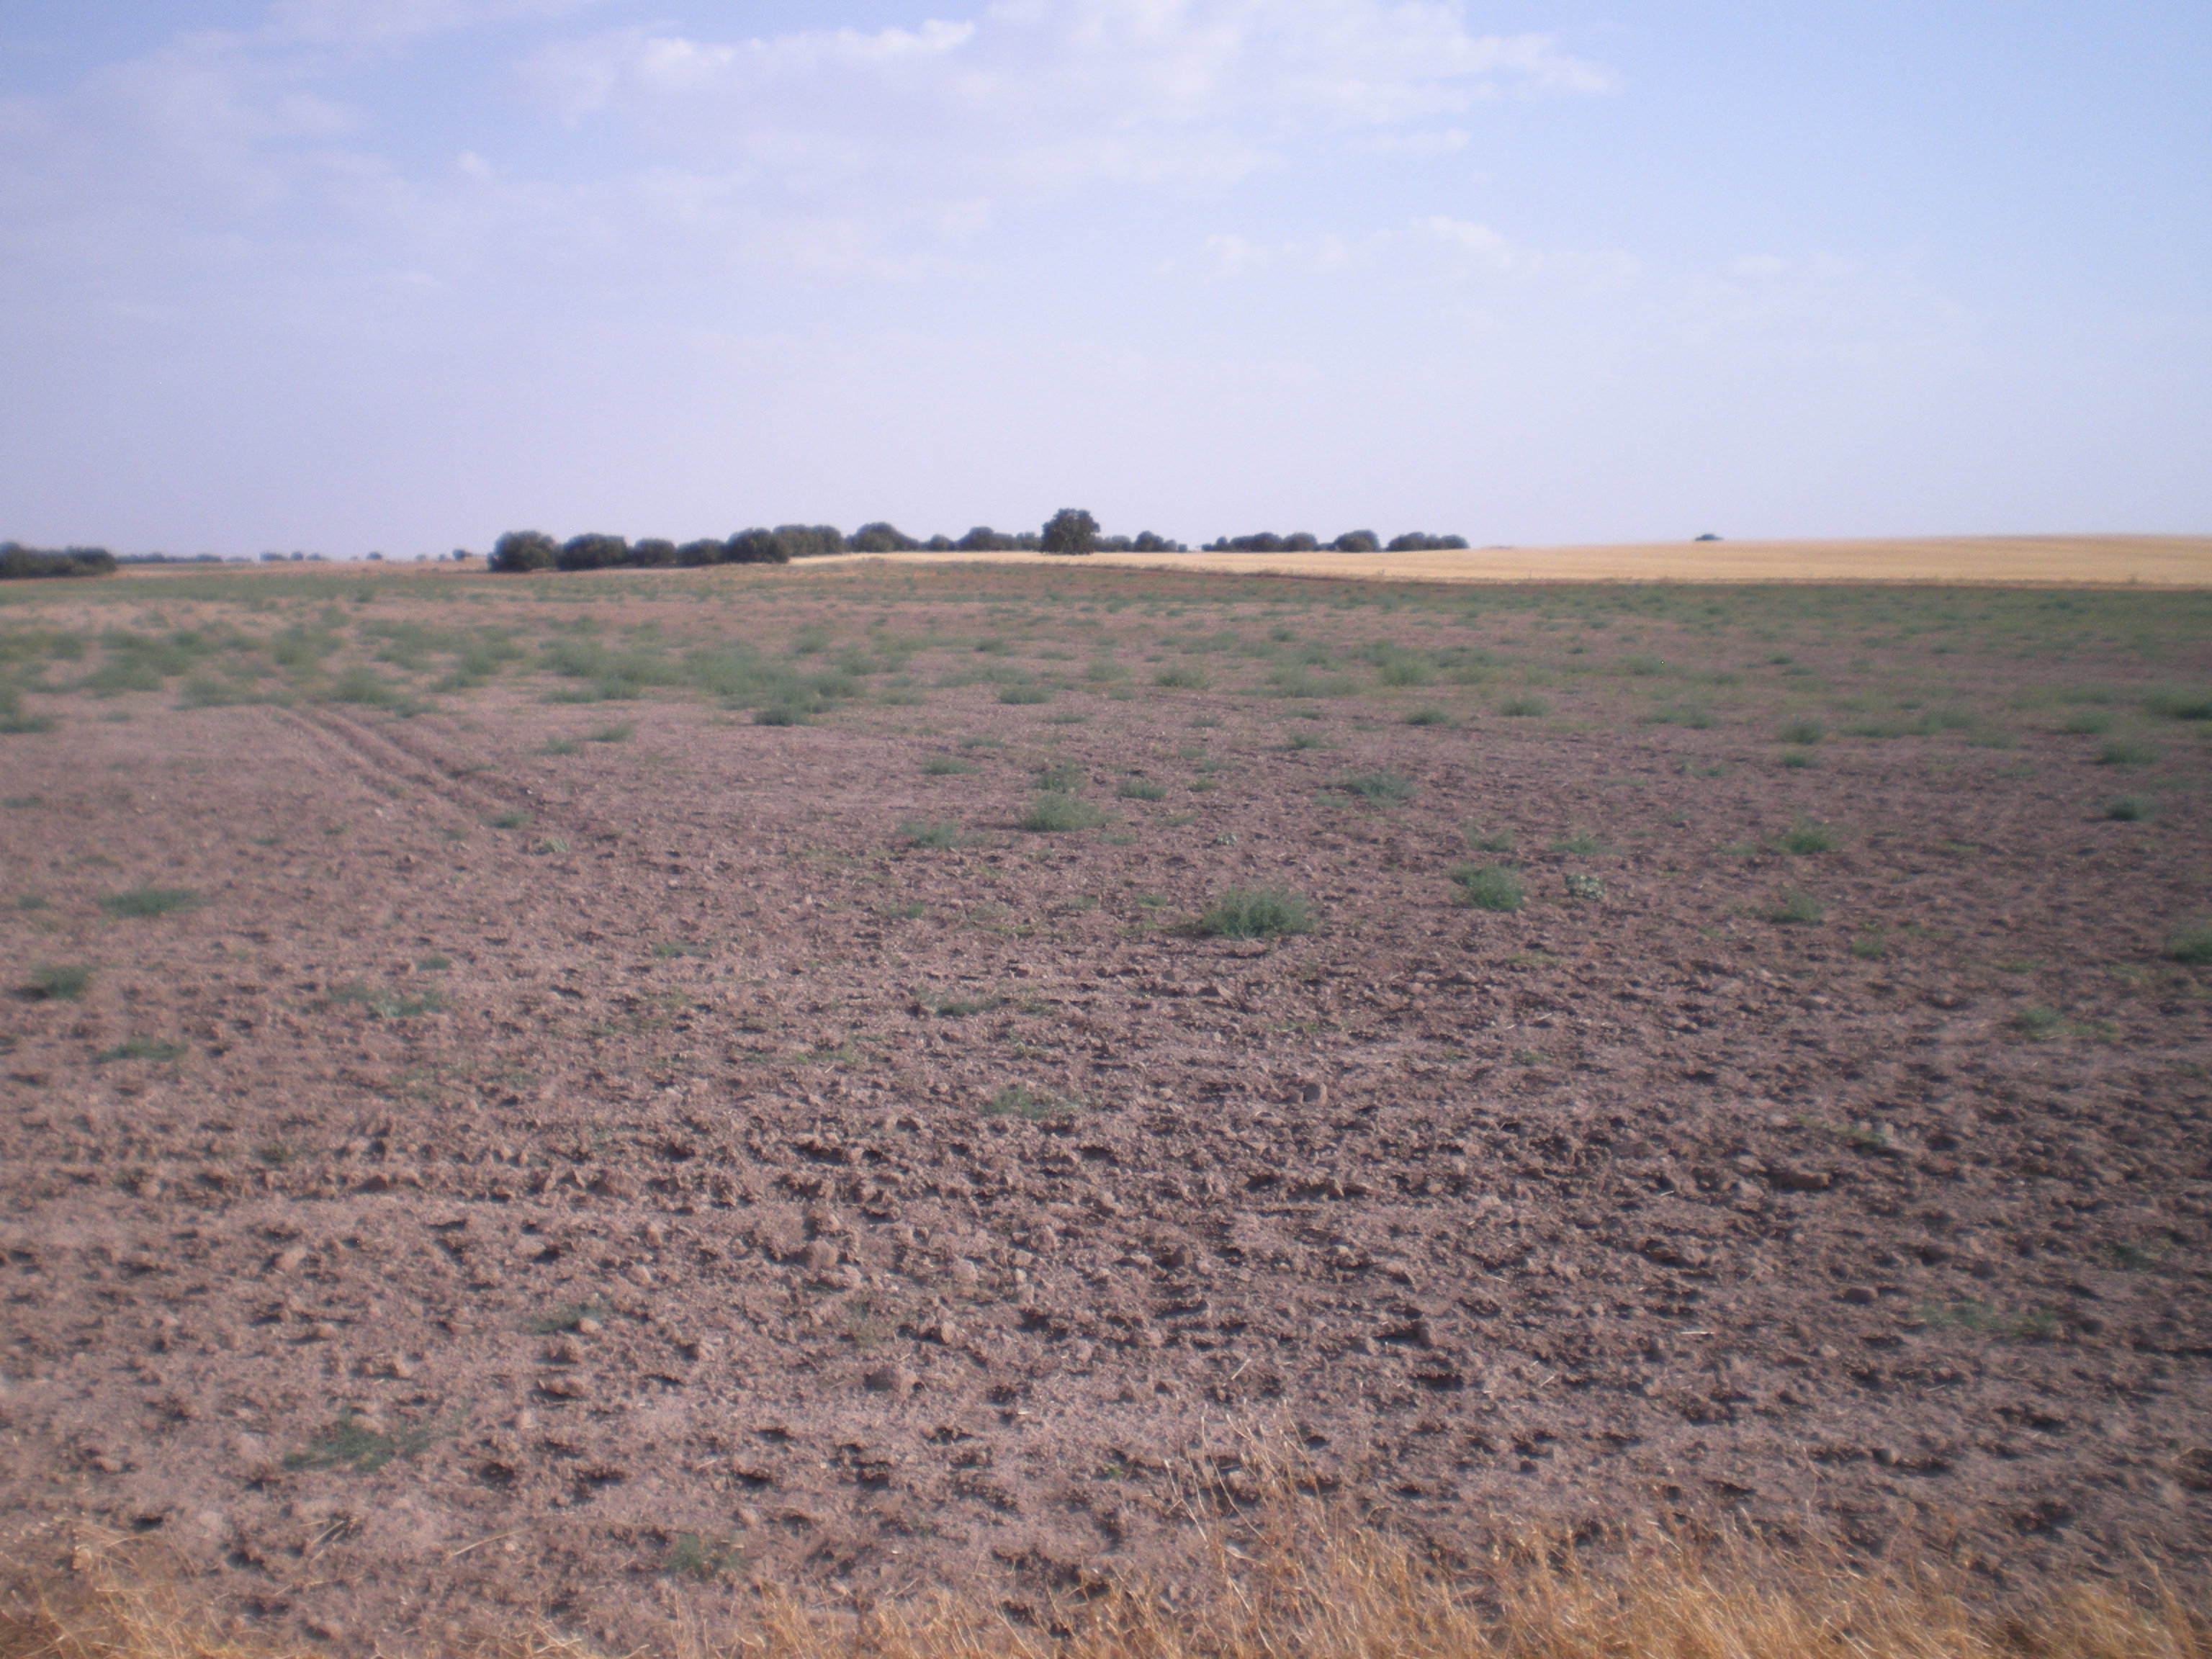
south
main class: Cropland
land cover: Dry pulses
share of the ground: < 10 %
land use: Agriculture (excluding fallow land and kitchen gardens)
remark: Harvested field
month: July
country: ES
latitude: 39.2612
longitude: -3.3337
